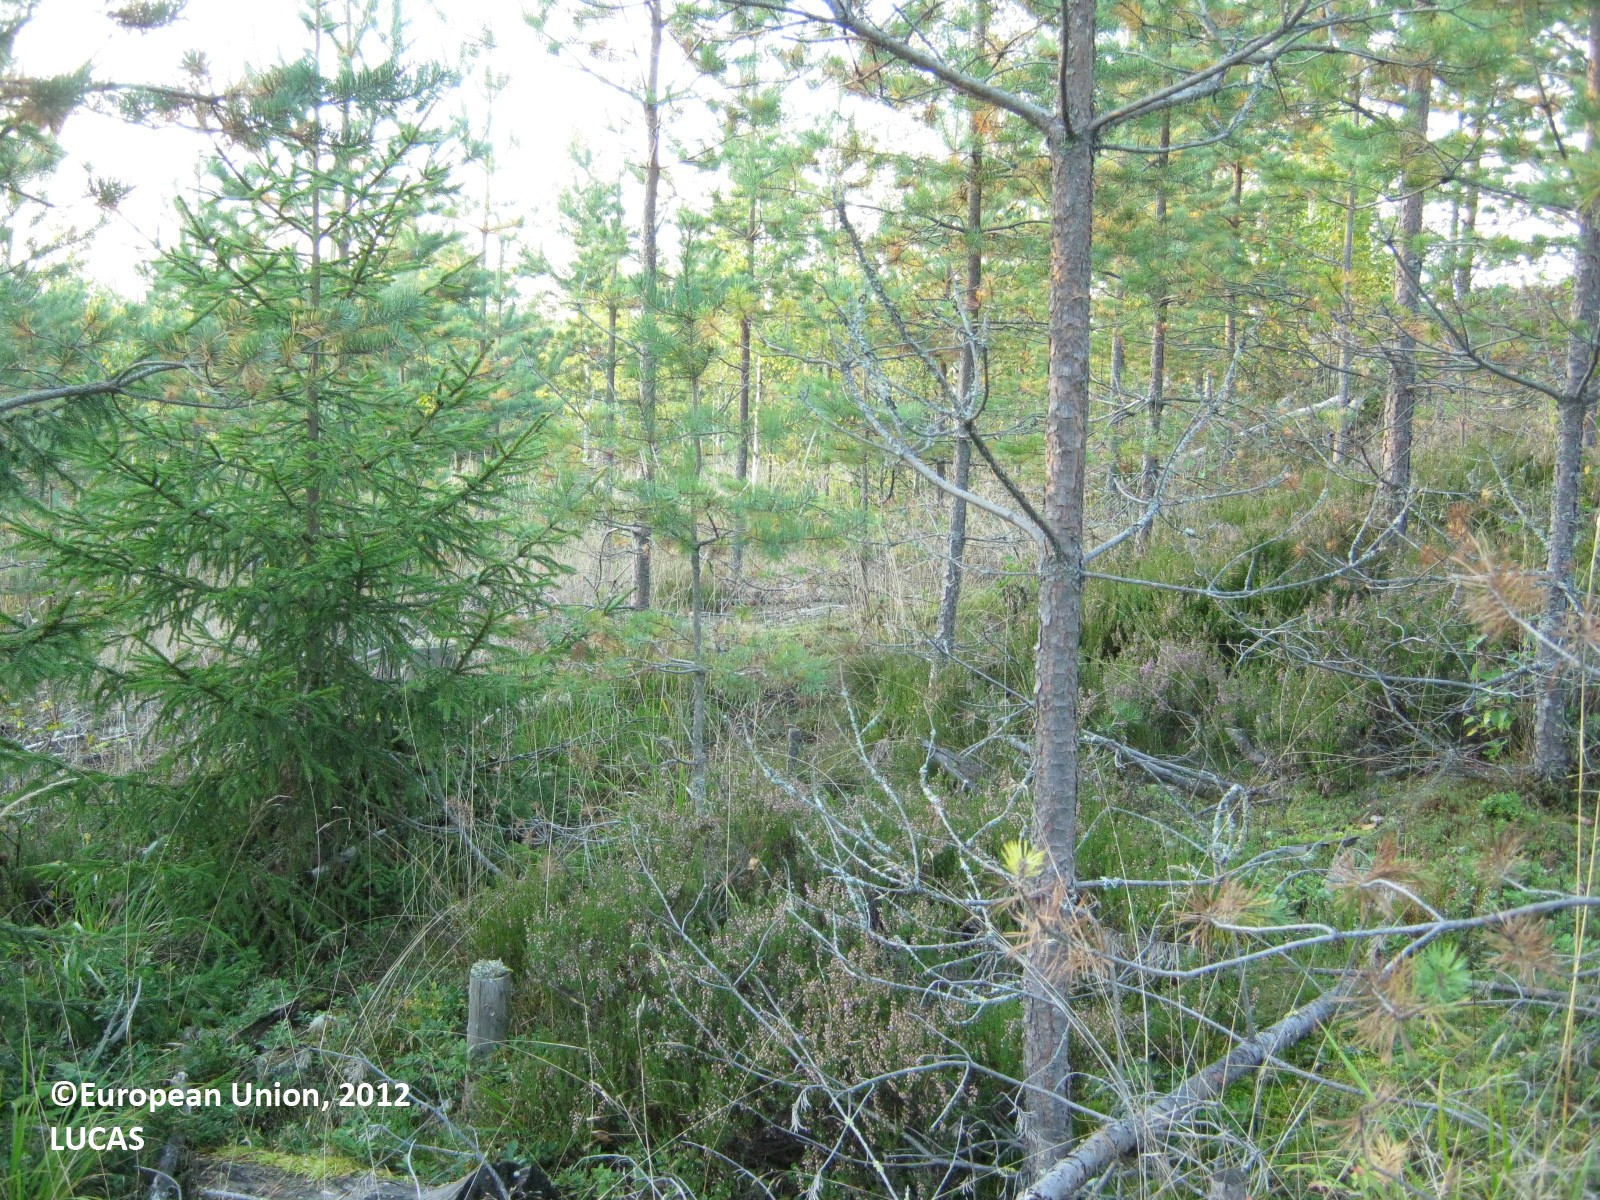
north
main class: Woodland
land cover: Pine dominated coniferous woodland
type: boreal forest
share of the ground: > 75 %
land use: Forestry
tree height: < 5 m
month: September
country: FI
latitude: 60.7750
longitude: 27.9547
